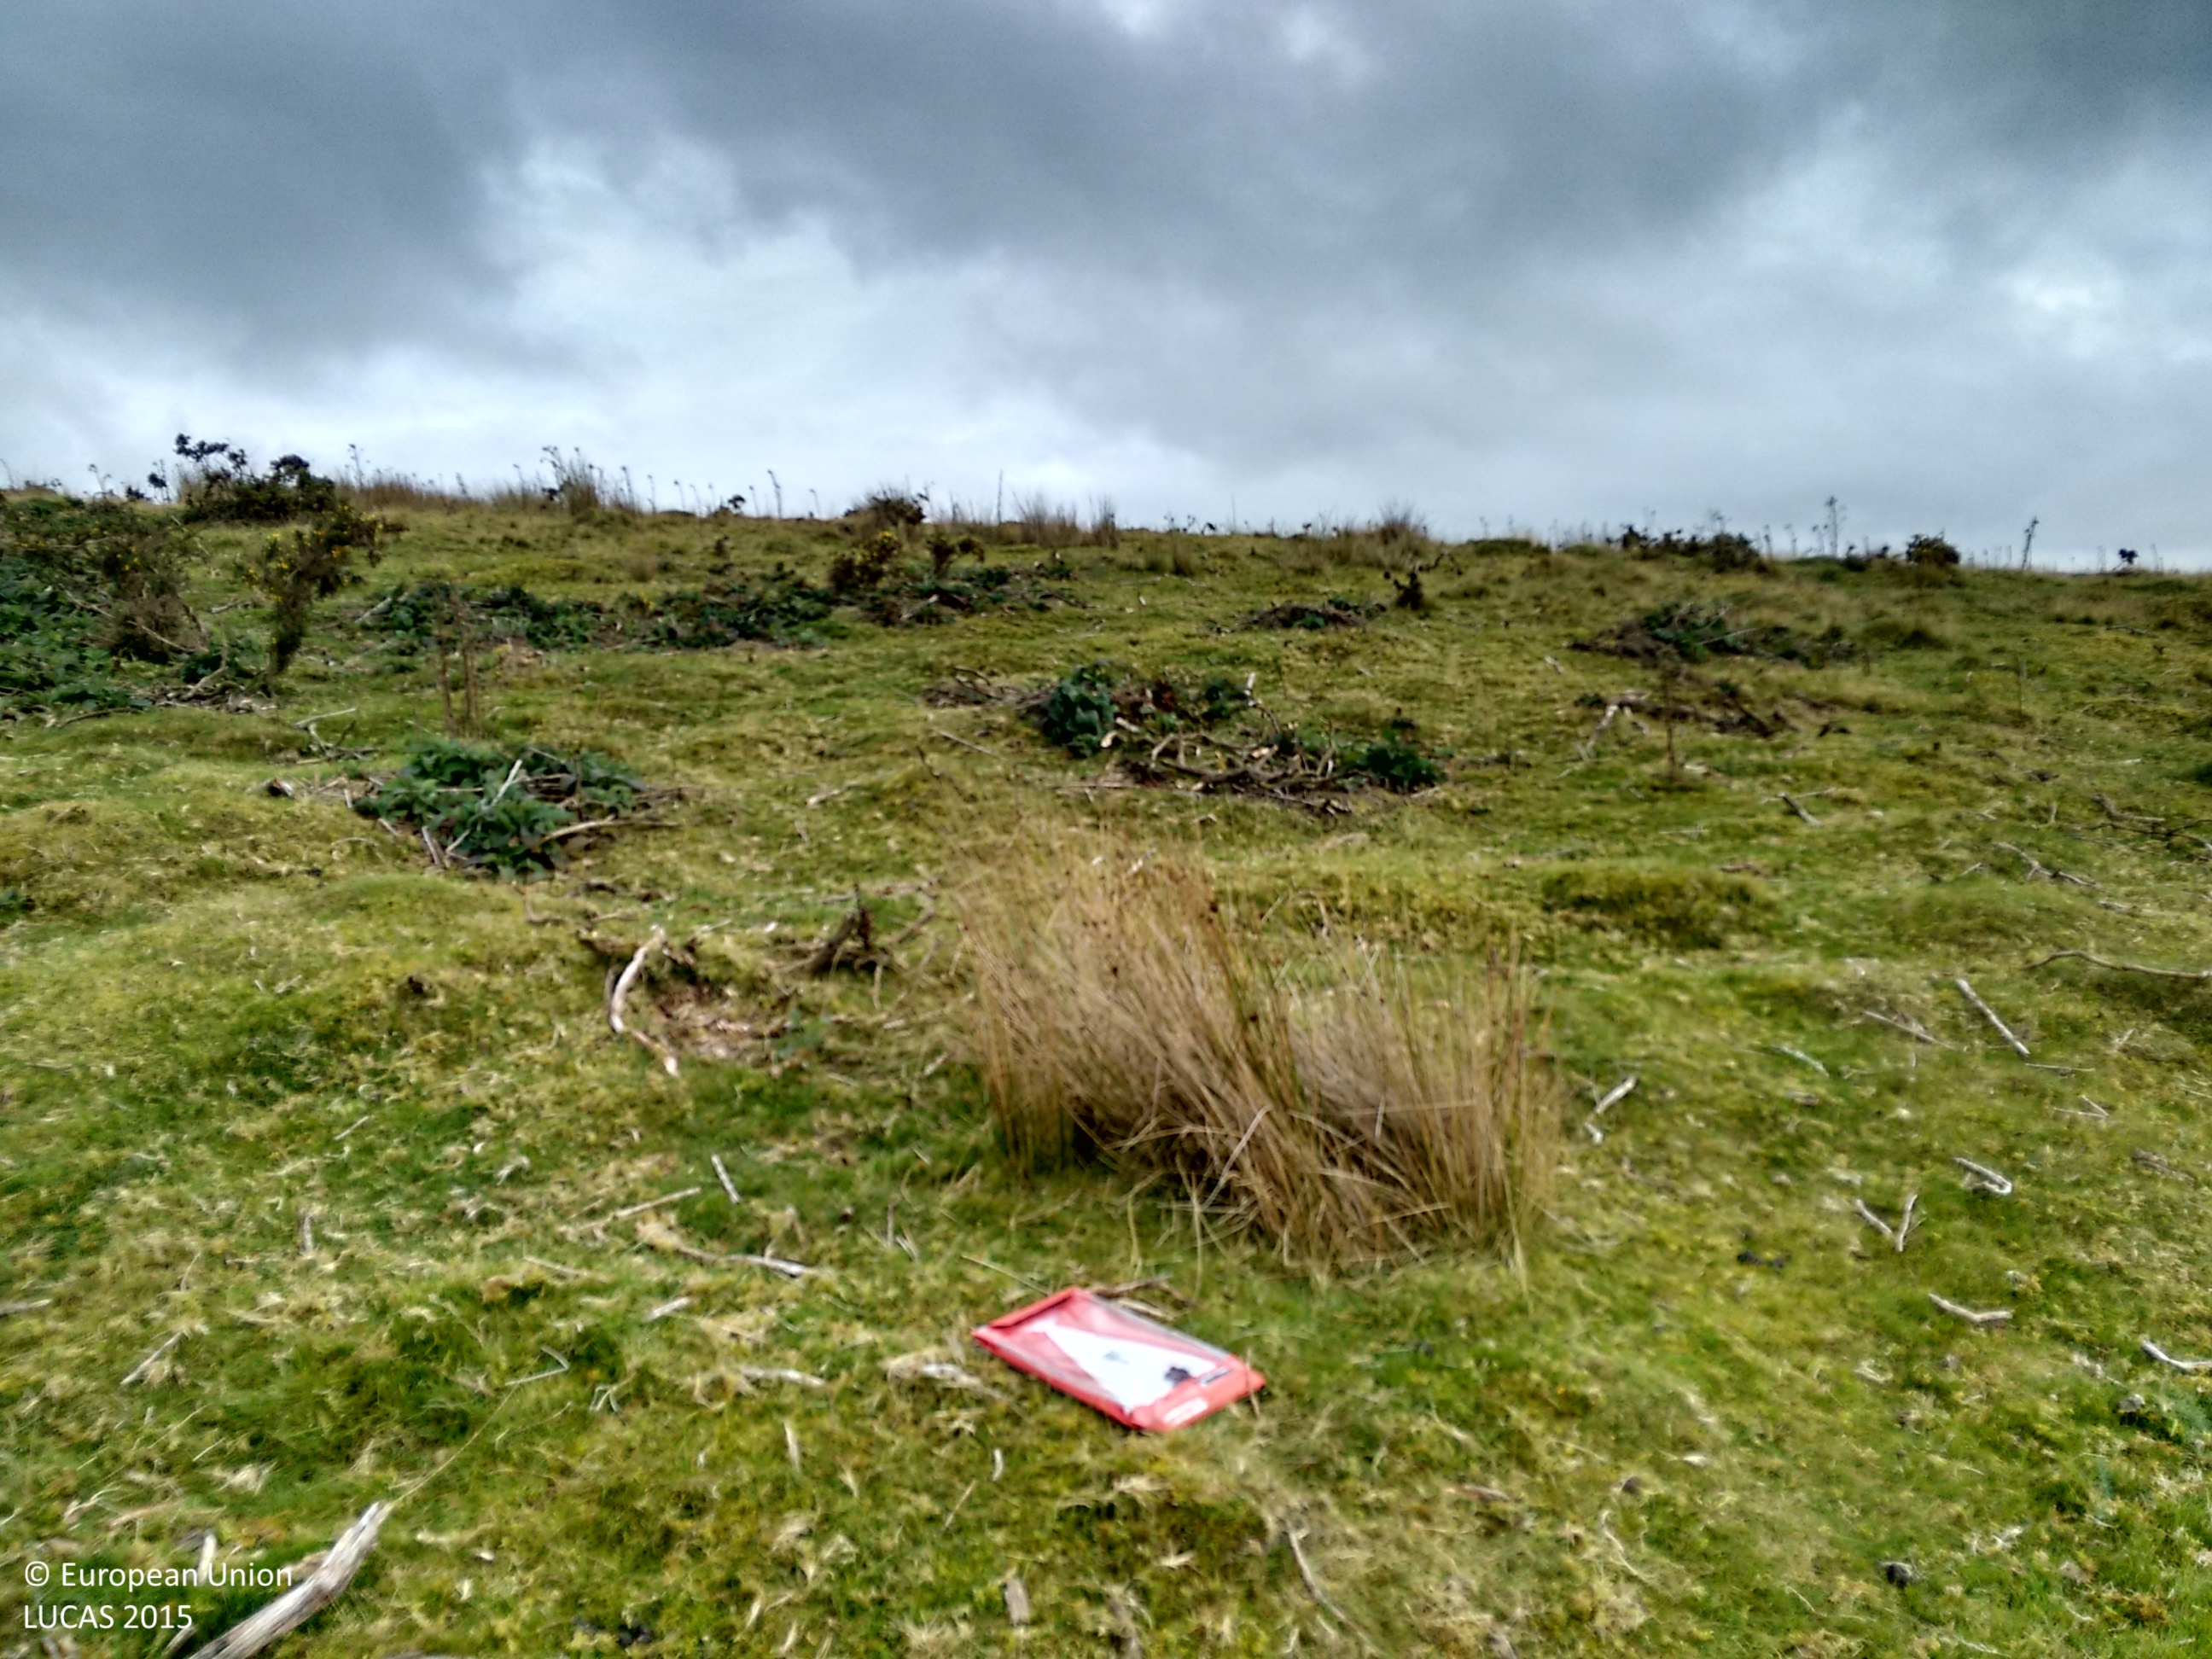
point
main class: Grassland
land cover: Grassland without tree/shrub cover
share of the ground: > 75 %
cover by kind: herbaceous plants 90 %, shrubs 5 %, lichens and mosses 5 %
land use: Agriculture (excluding fallow land and kitchen gardens)
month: October
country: GB
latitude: 52.2649
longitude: -3.2823
